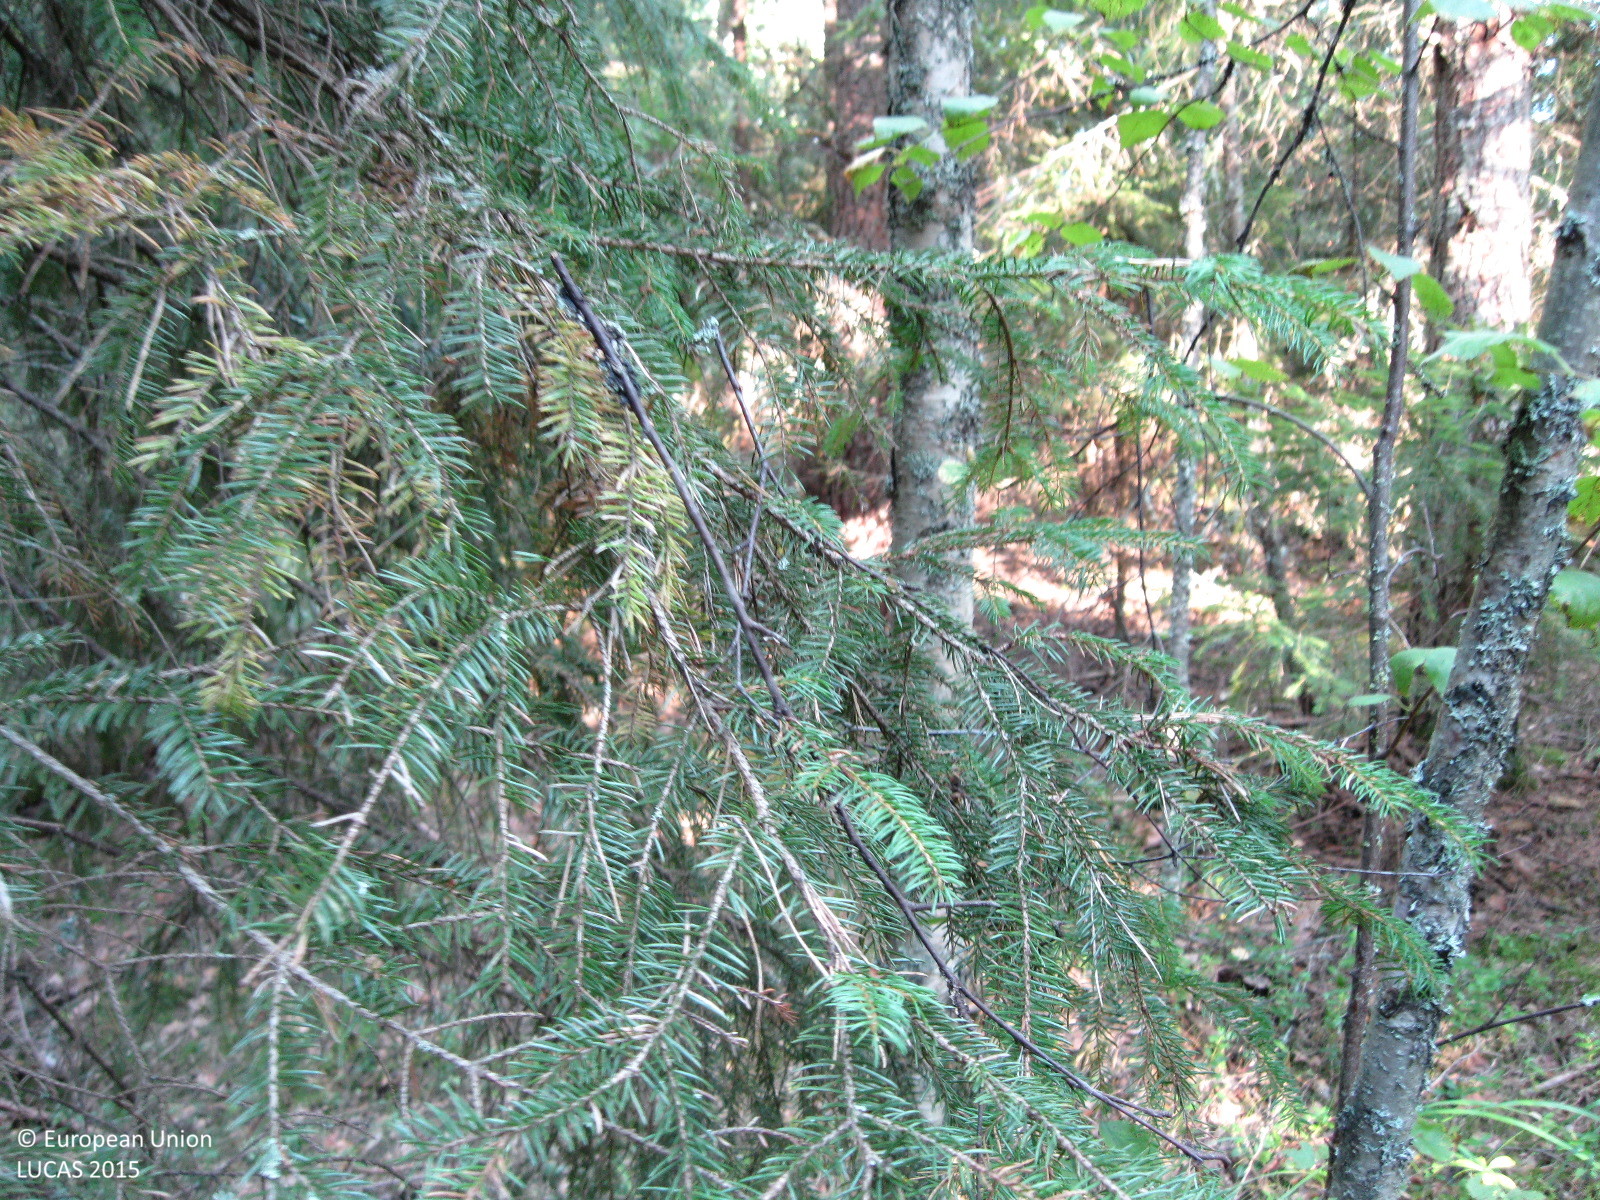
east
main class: Woodland
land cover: Pine dominated mixed woodland
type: boreal forest
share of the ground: > 75 %
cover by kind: coniferous forest trees 65 %, broadleaved forest trees 25 %, shrubs 5 %, herbaceous plants 5 %
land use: Forestry
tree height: > 5 m
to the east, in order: Pine dominated mixed woodland; Tracks; Spruce dominated coniferous woodland; Broadleaved woodland; Inland fresh running water; Spruce dominated mixed woodland; Inland fresh running water; Spruce dominated mixed woodland
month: August
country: FI
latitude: 61.2903
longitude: 25.2895
